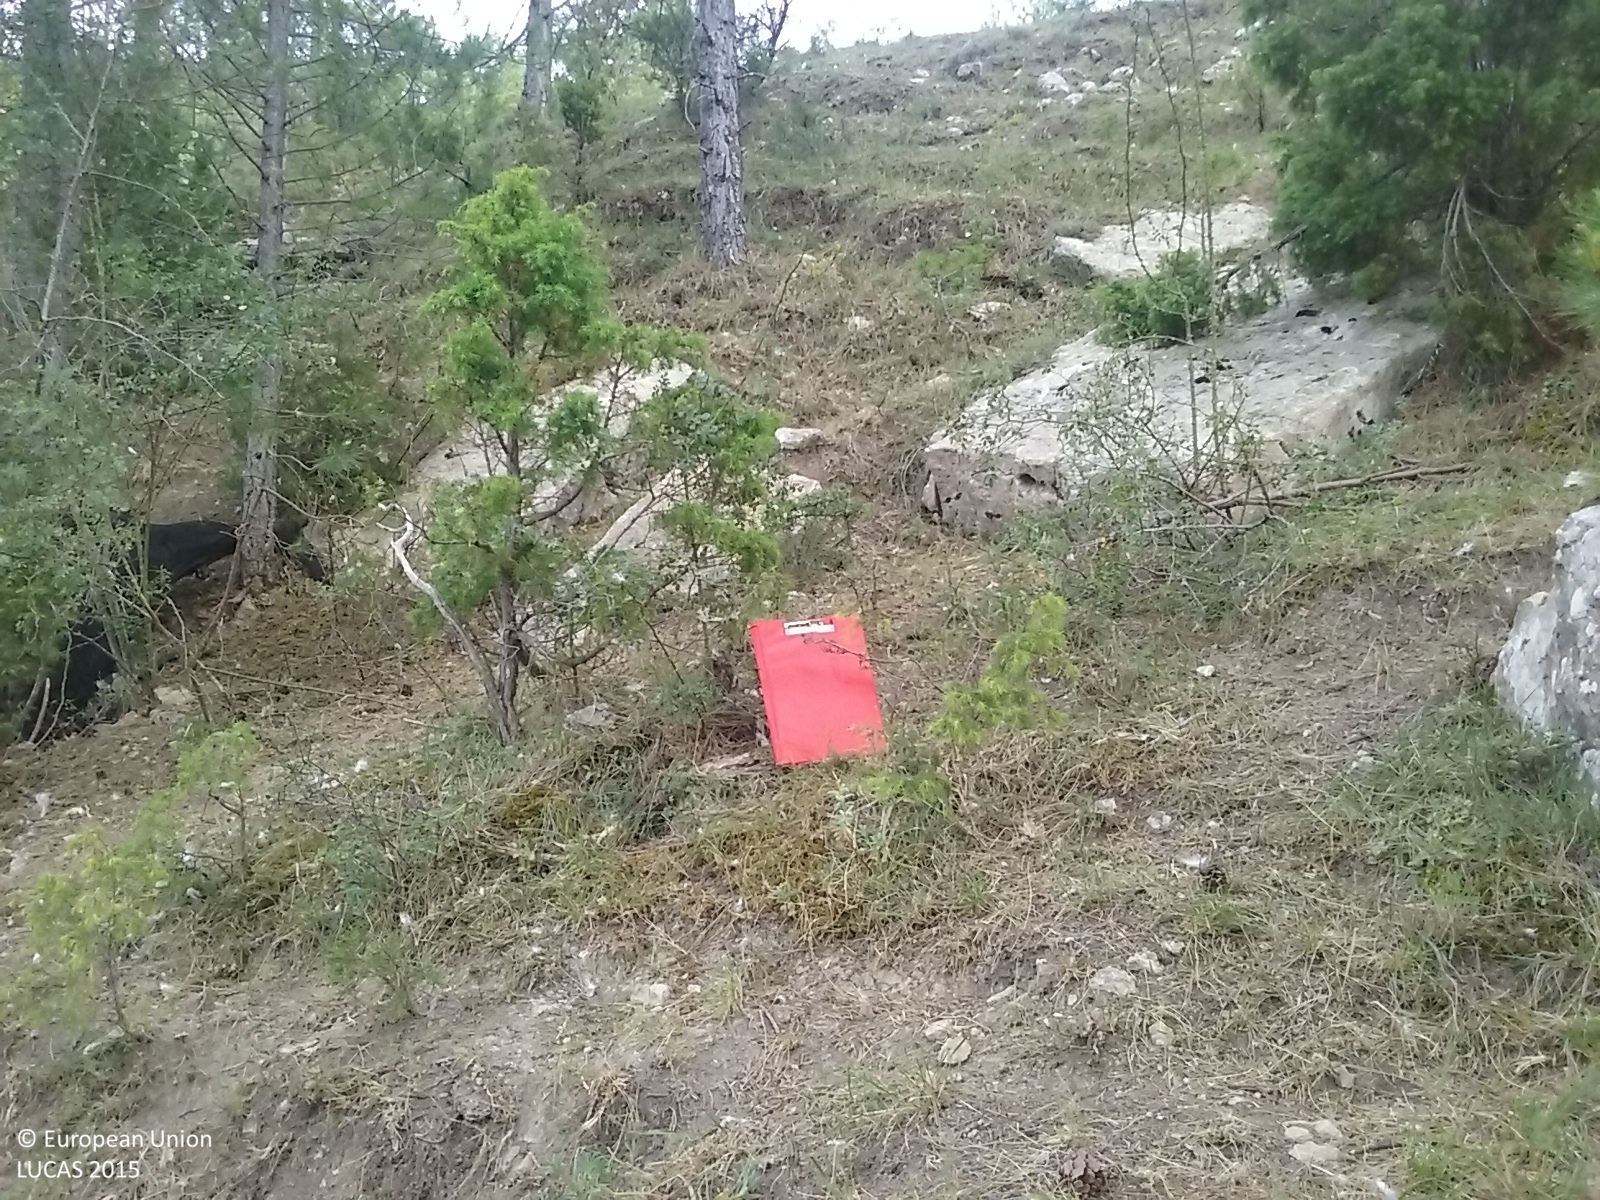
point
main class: Woodland
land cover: Pine dominated coniferous woodland
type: coniferous forest of the mediterranean region
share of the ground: 50 - 75 %
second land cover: Shrubland without tree cover
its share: 10 - 25 %
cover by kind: coniferous forest trees 60 %, shrubs 20 %, herbaceous plants 20 %
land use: Forestry
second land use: Agriculture (excluding fallow land and kitchen gardens)
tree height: > 5 m
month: June
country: ES
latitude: 40.7562
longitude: 0.1733
